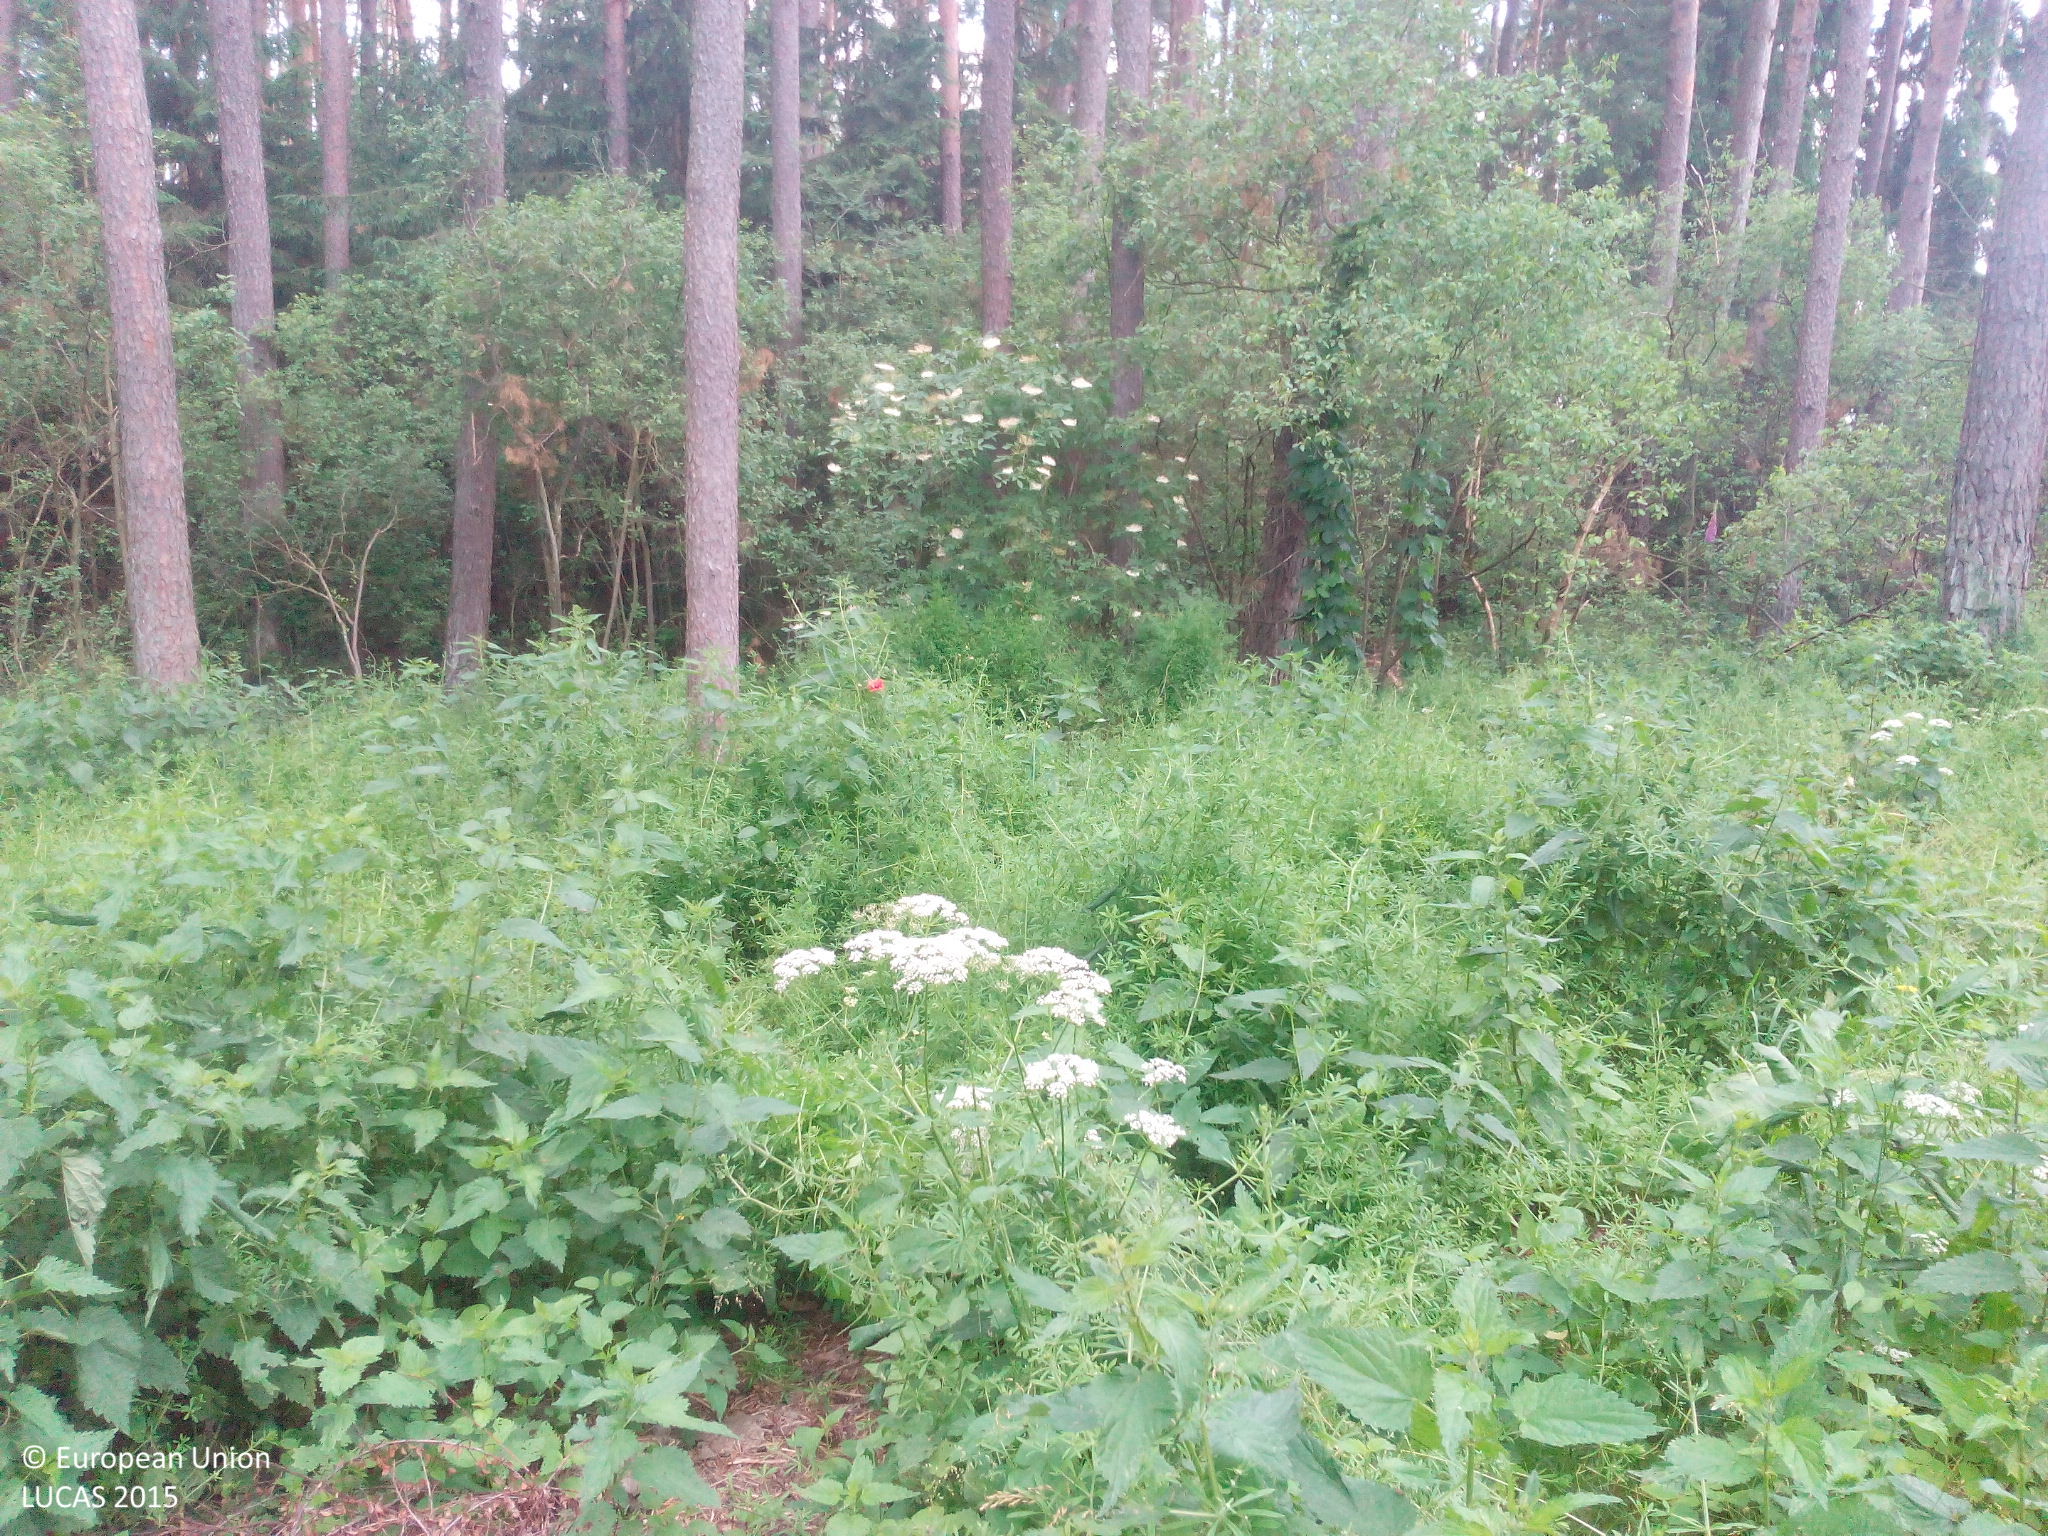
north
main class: Woodland
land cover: Pine dominated coniferous woodland
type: hemiboreal forest and nemoral coniferous forest and mixed broadleaved-coniferous forest
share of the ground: 50 - 75 %
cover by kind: coniferous forest trees 70 %, herbaceous plants 20 %, shrubs 10 %
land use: Forestry
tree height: > 5 m
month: June
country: DE
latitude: 49.2093
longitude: 10.9193
